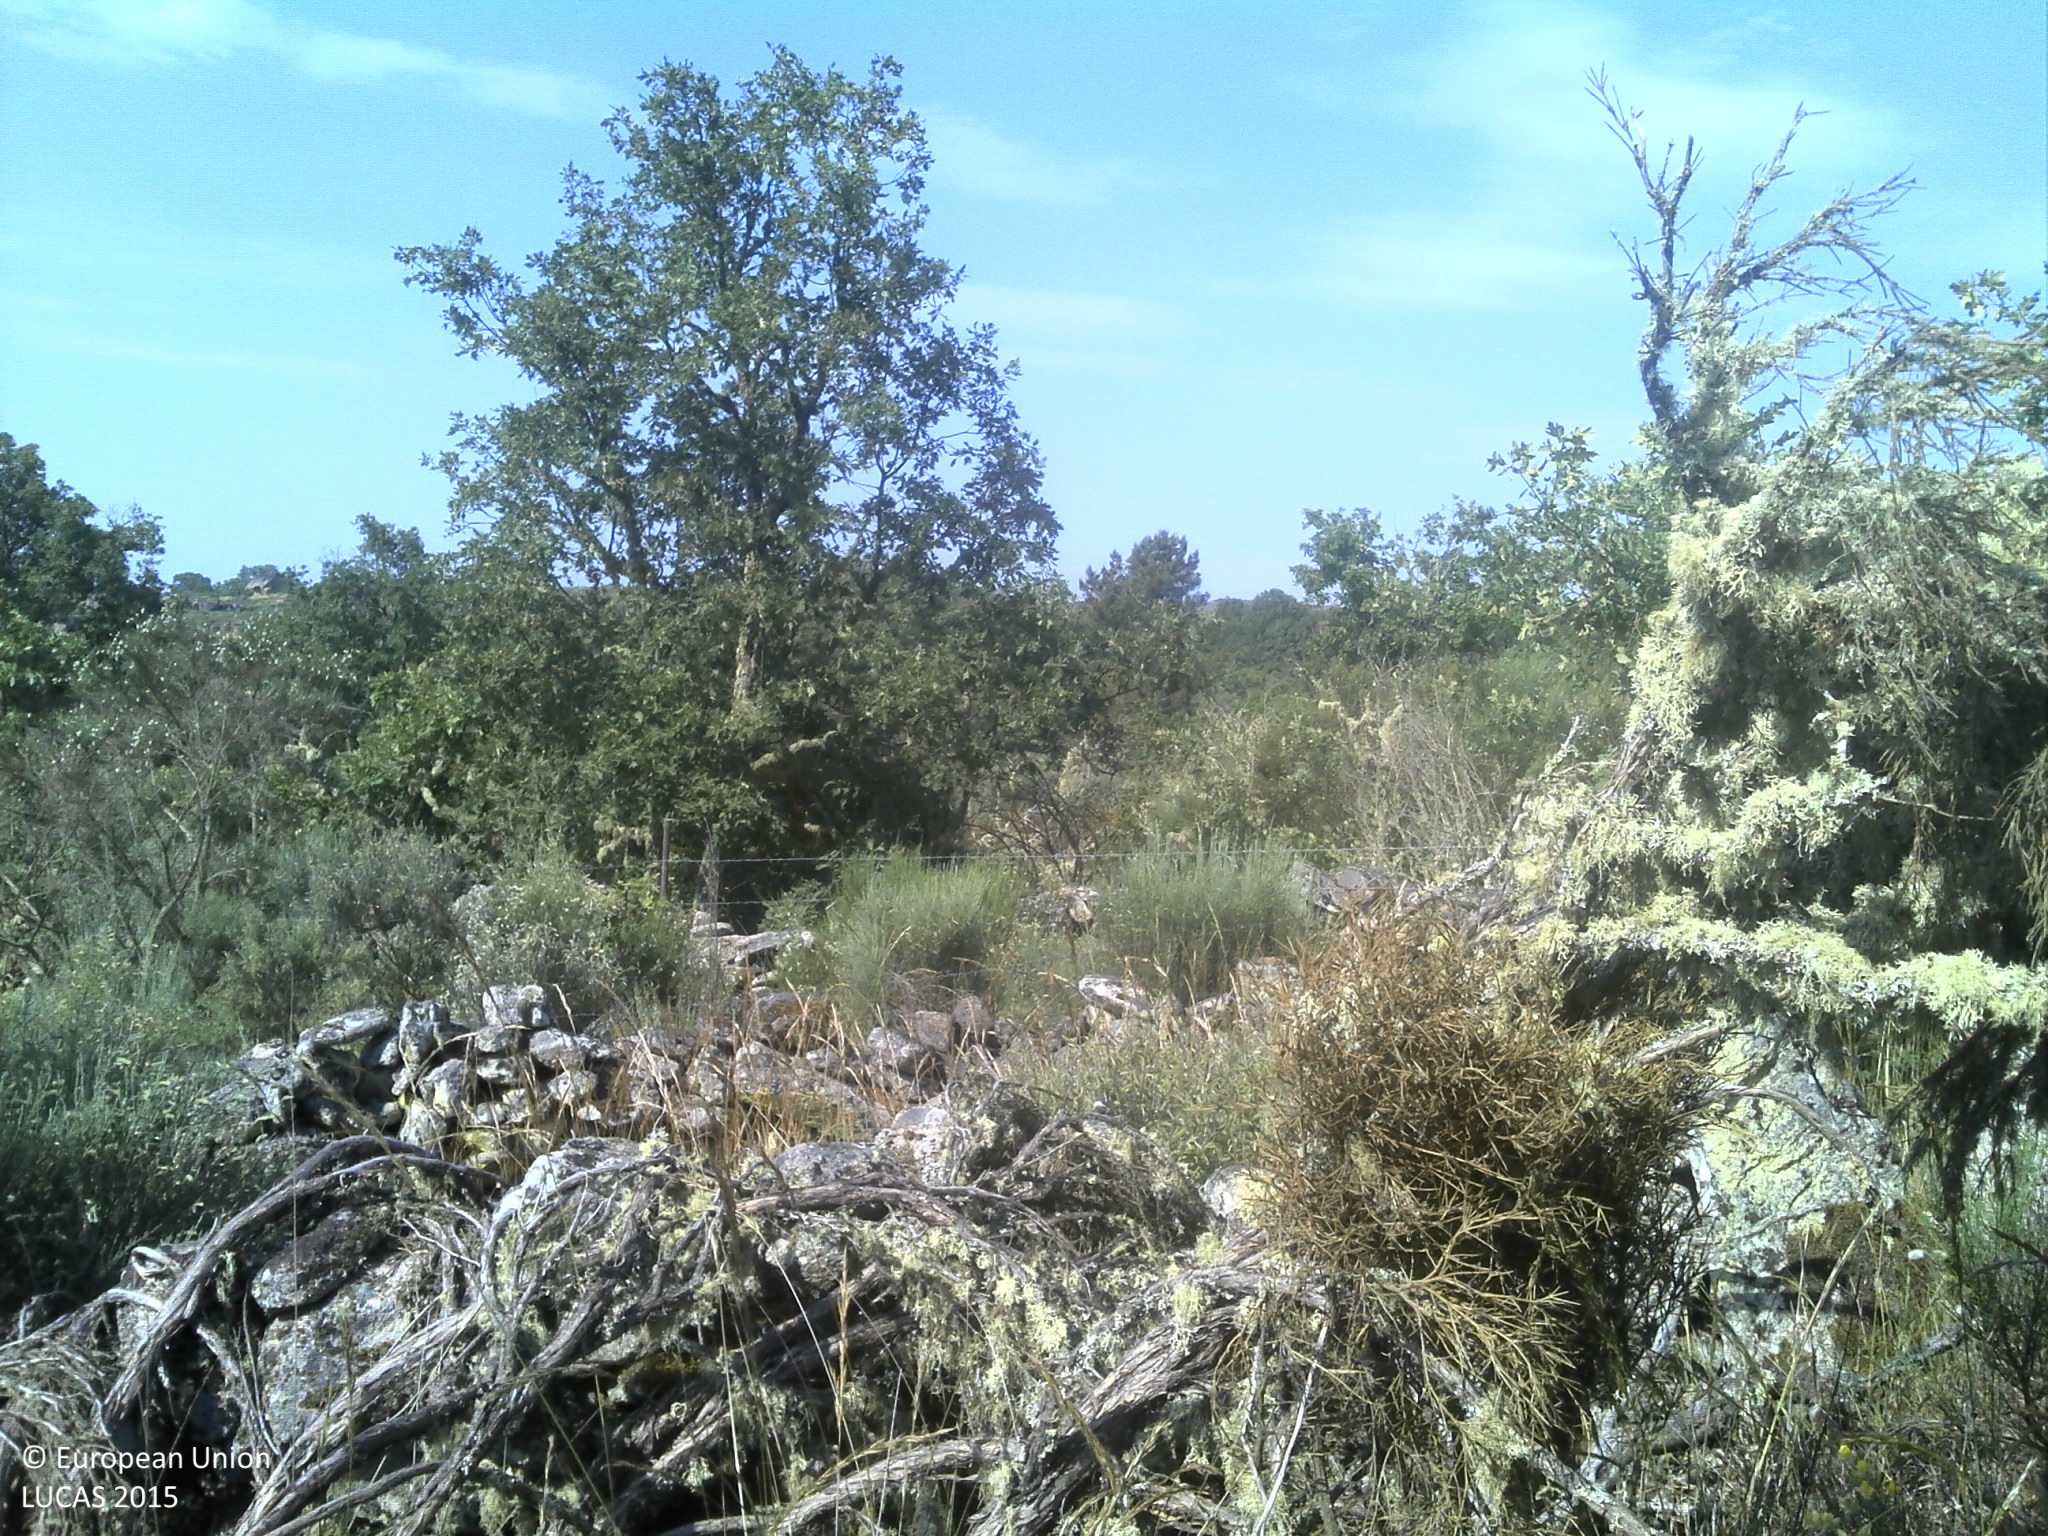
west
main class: Shrubland
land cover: Shrubland with sparse tree cover
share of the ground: 50 - 75 %
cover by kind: shrubs 75 %, unconsolidated bare surface 10 %, broadleaved forest trees 5 %
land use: Abandoned areas
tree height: < 5 m
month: June
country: PT
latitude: 40.5745
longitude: -7.1253
